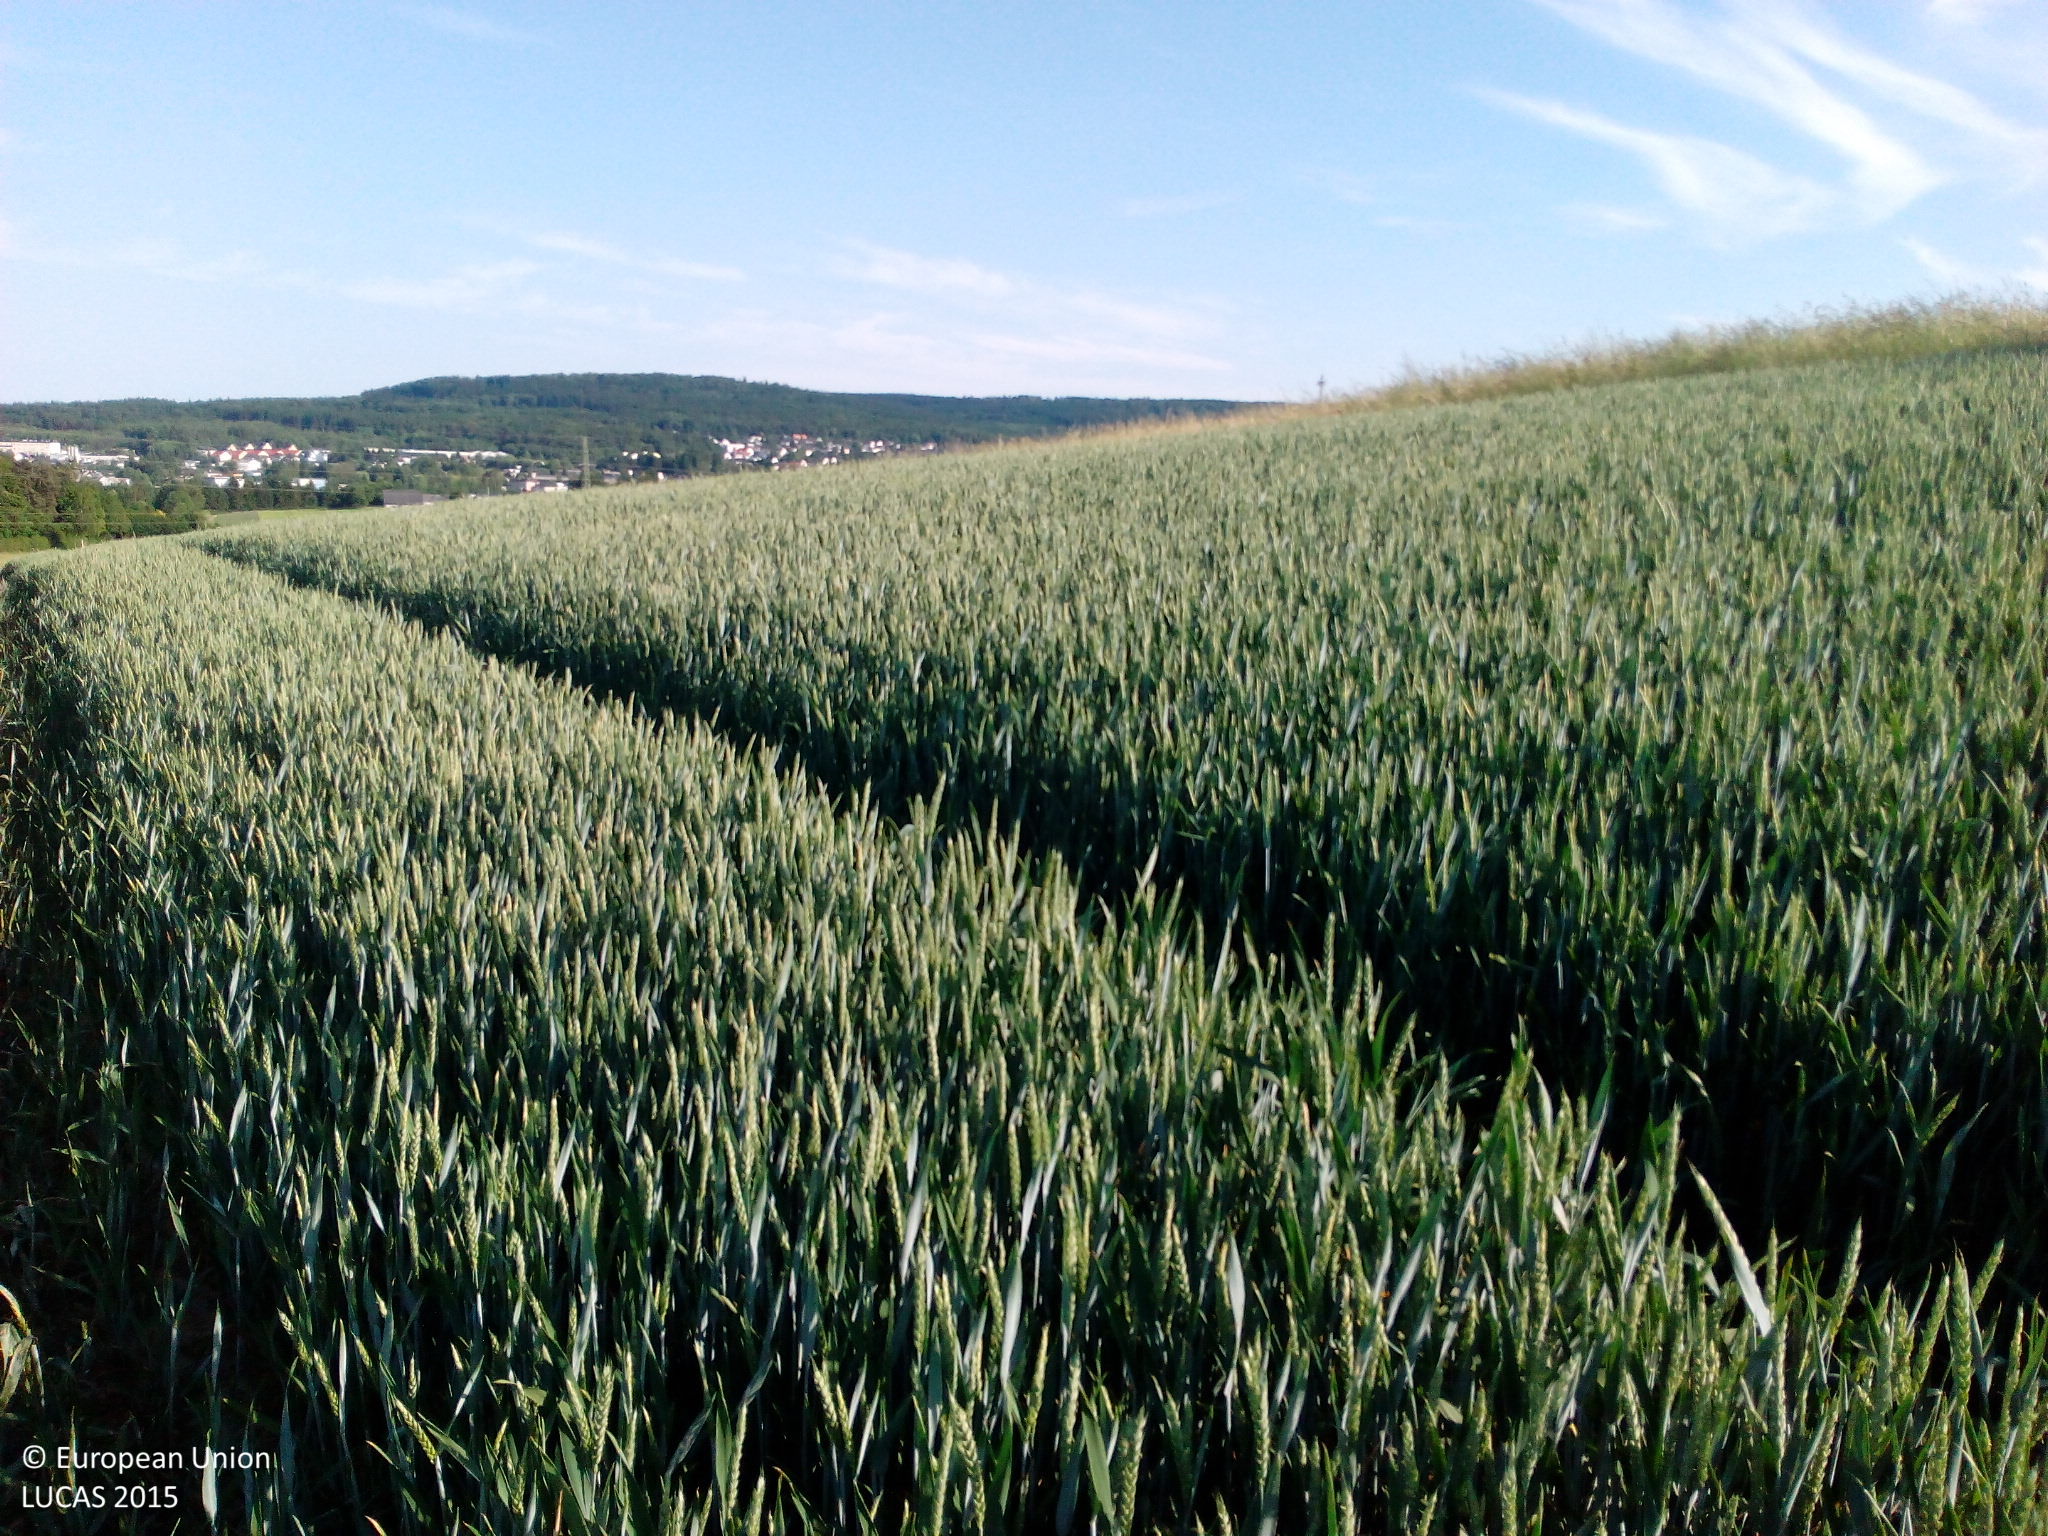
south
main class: Cropland
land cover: Common wheat
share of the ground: > 75 %
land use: Agriculture (excluding fallow land and kitchen gardens)
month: June
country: DE
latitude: 50.1511
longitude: 8.1390
